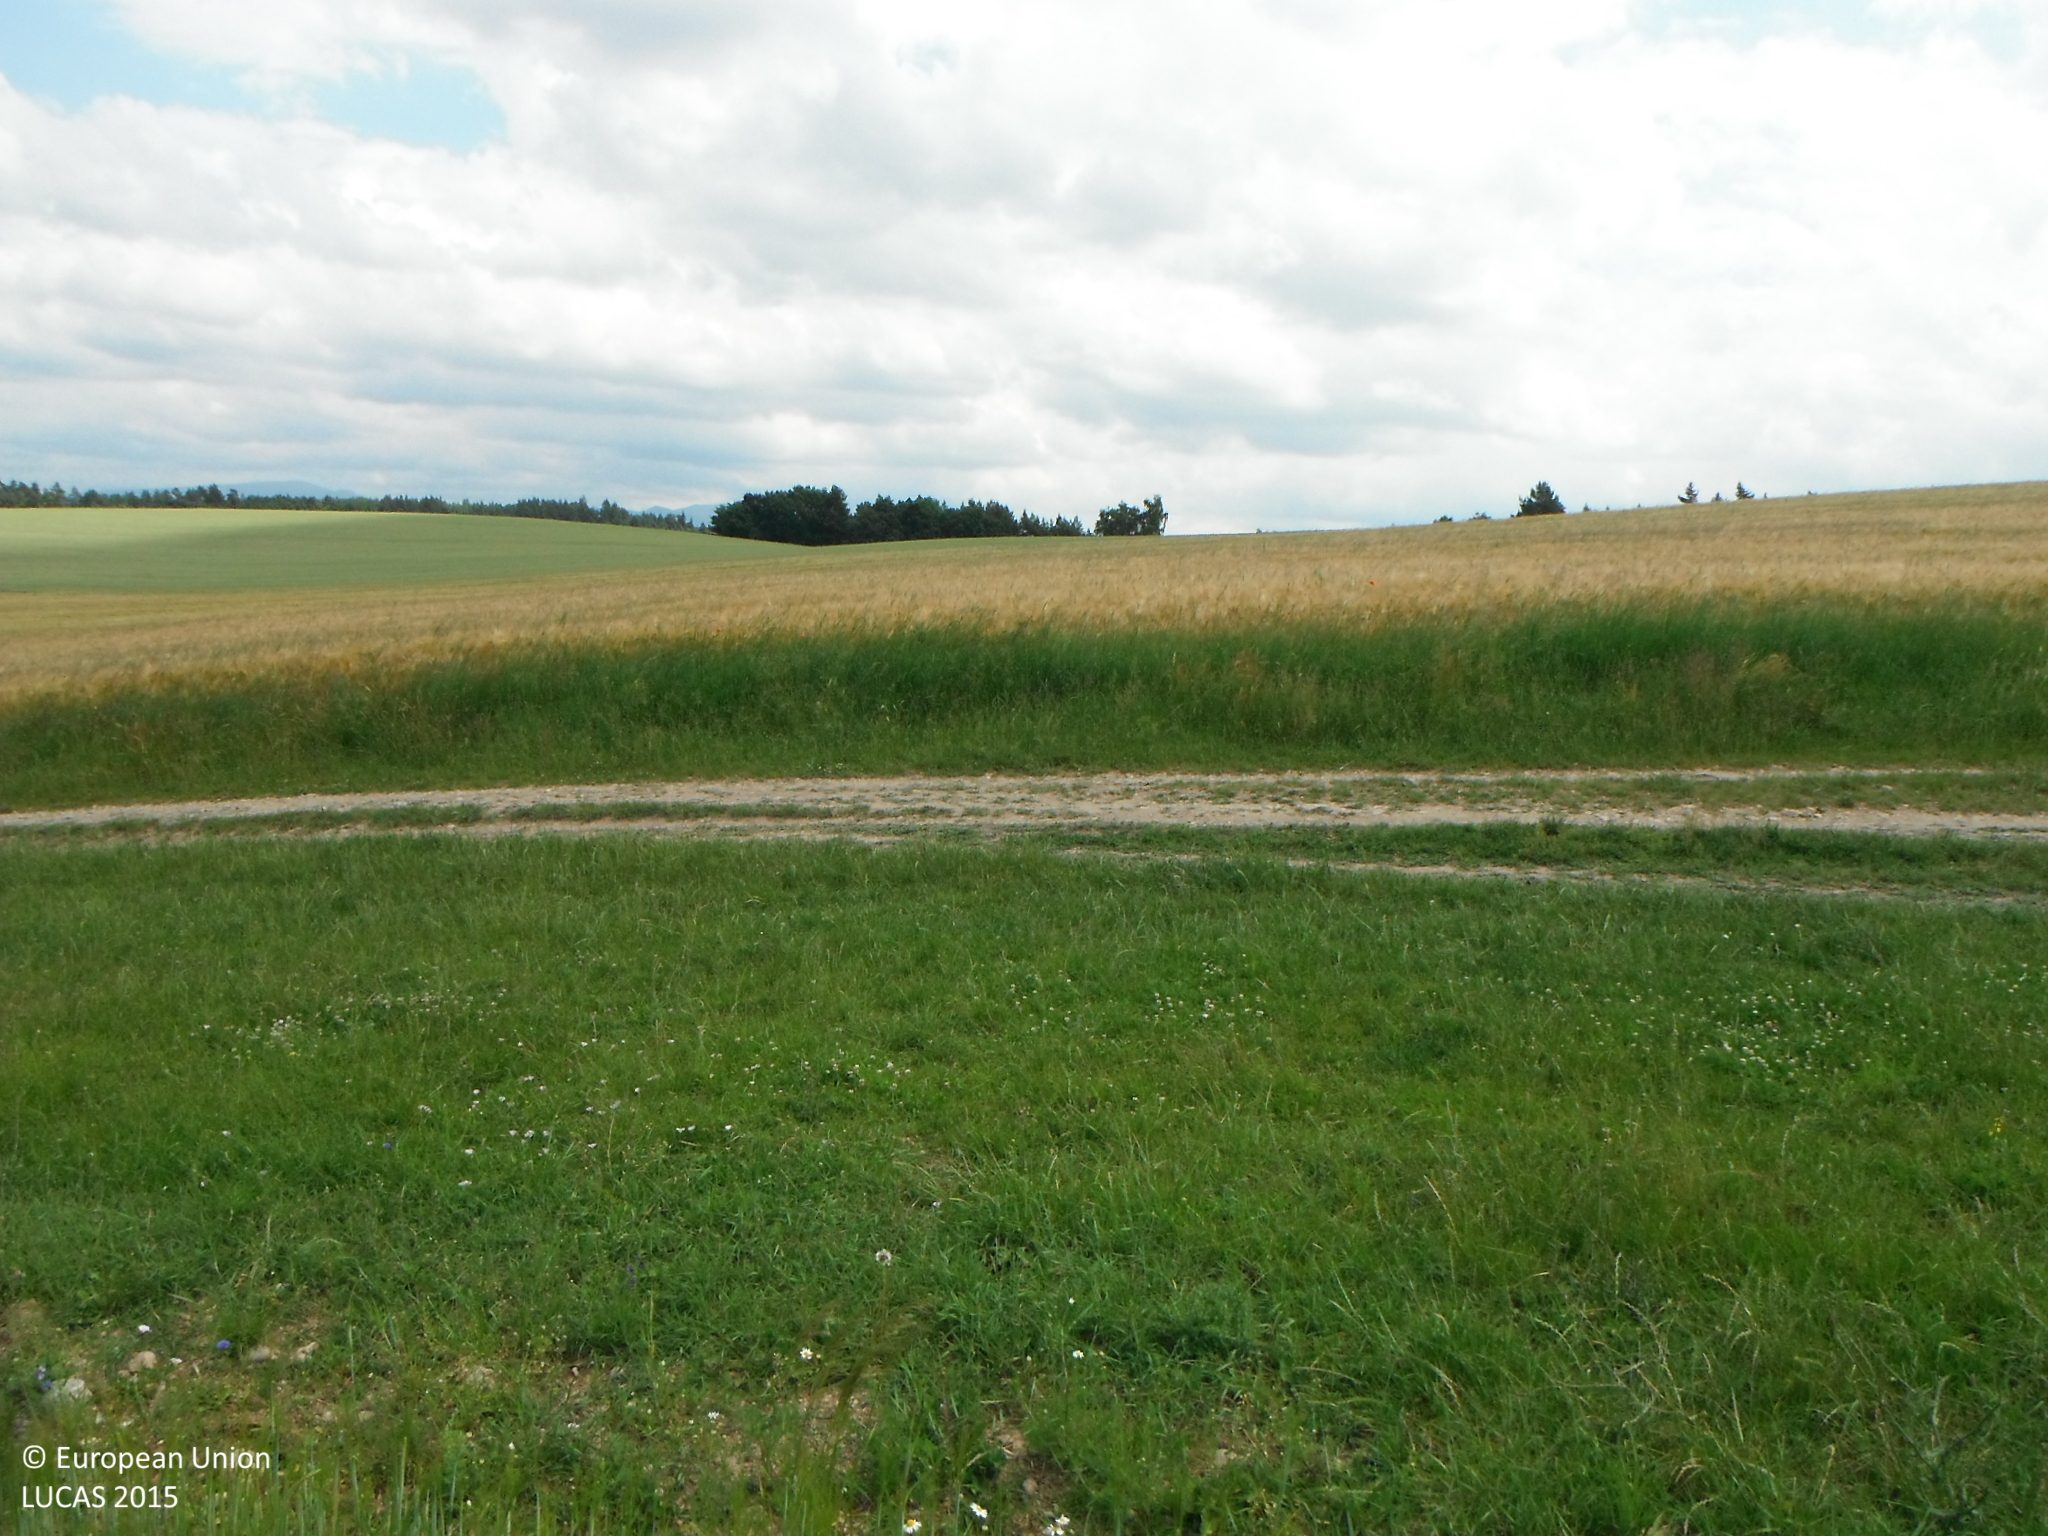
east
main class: Cropland
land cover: Barley
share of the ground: > 75 %
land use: Agriculture (excluding fallow land and kitchen gardens)
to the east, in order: Barley; Grassland without tree/shrub cover; Tracks; Grass margins; Barley; Common wheat
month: June
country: SK
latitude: 48.6185
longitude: 19.1790
